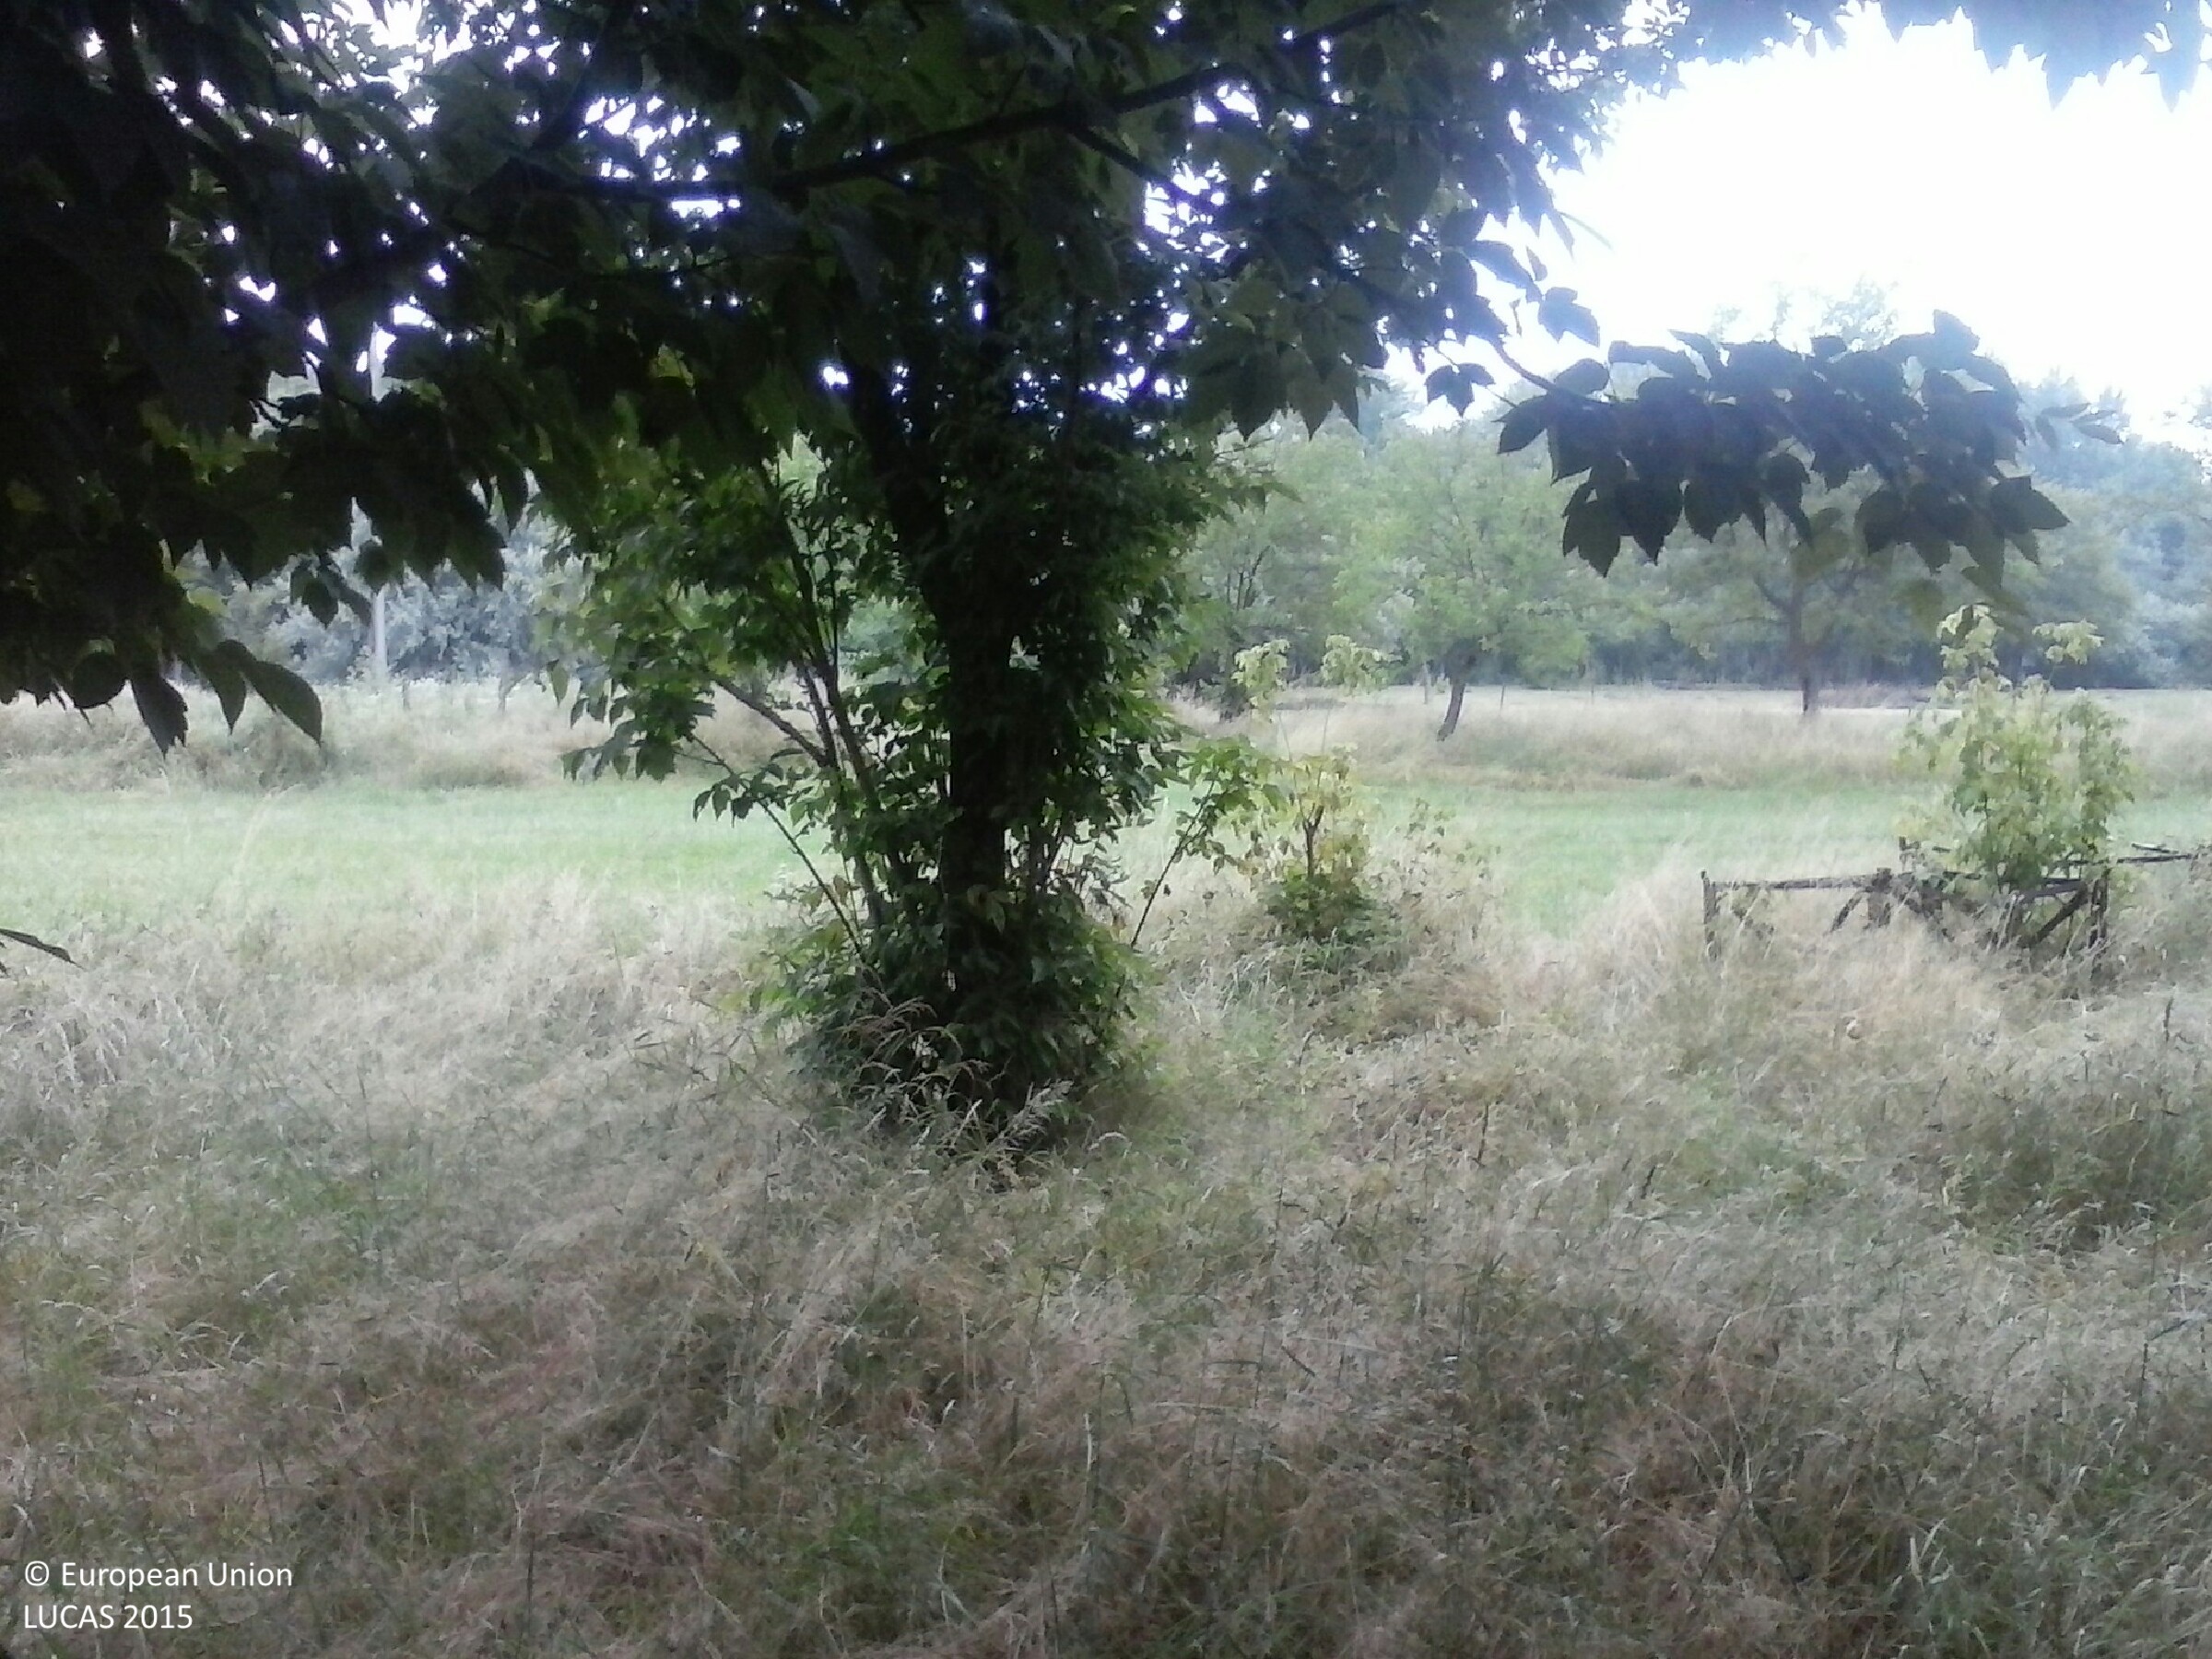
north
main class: Woodland
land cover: Broadleaved woodland
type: mesophytic deciduous forest
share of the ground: 25 - 50 %
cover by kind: herbaceous plants 70 %, broadleaved forest trees 25 %, shrubs 5 %
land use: Agriculture (excluding fallow land and kitchen gardens)
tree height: > 5 m
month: June
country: HU
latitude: 46.3291
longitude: 20.0625
